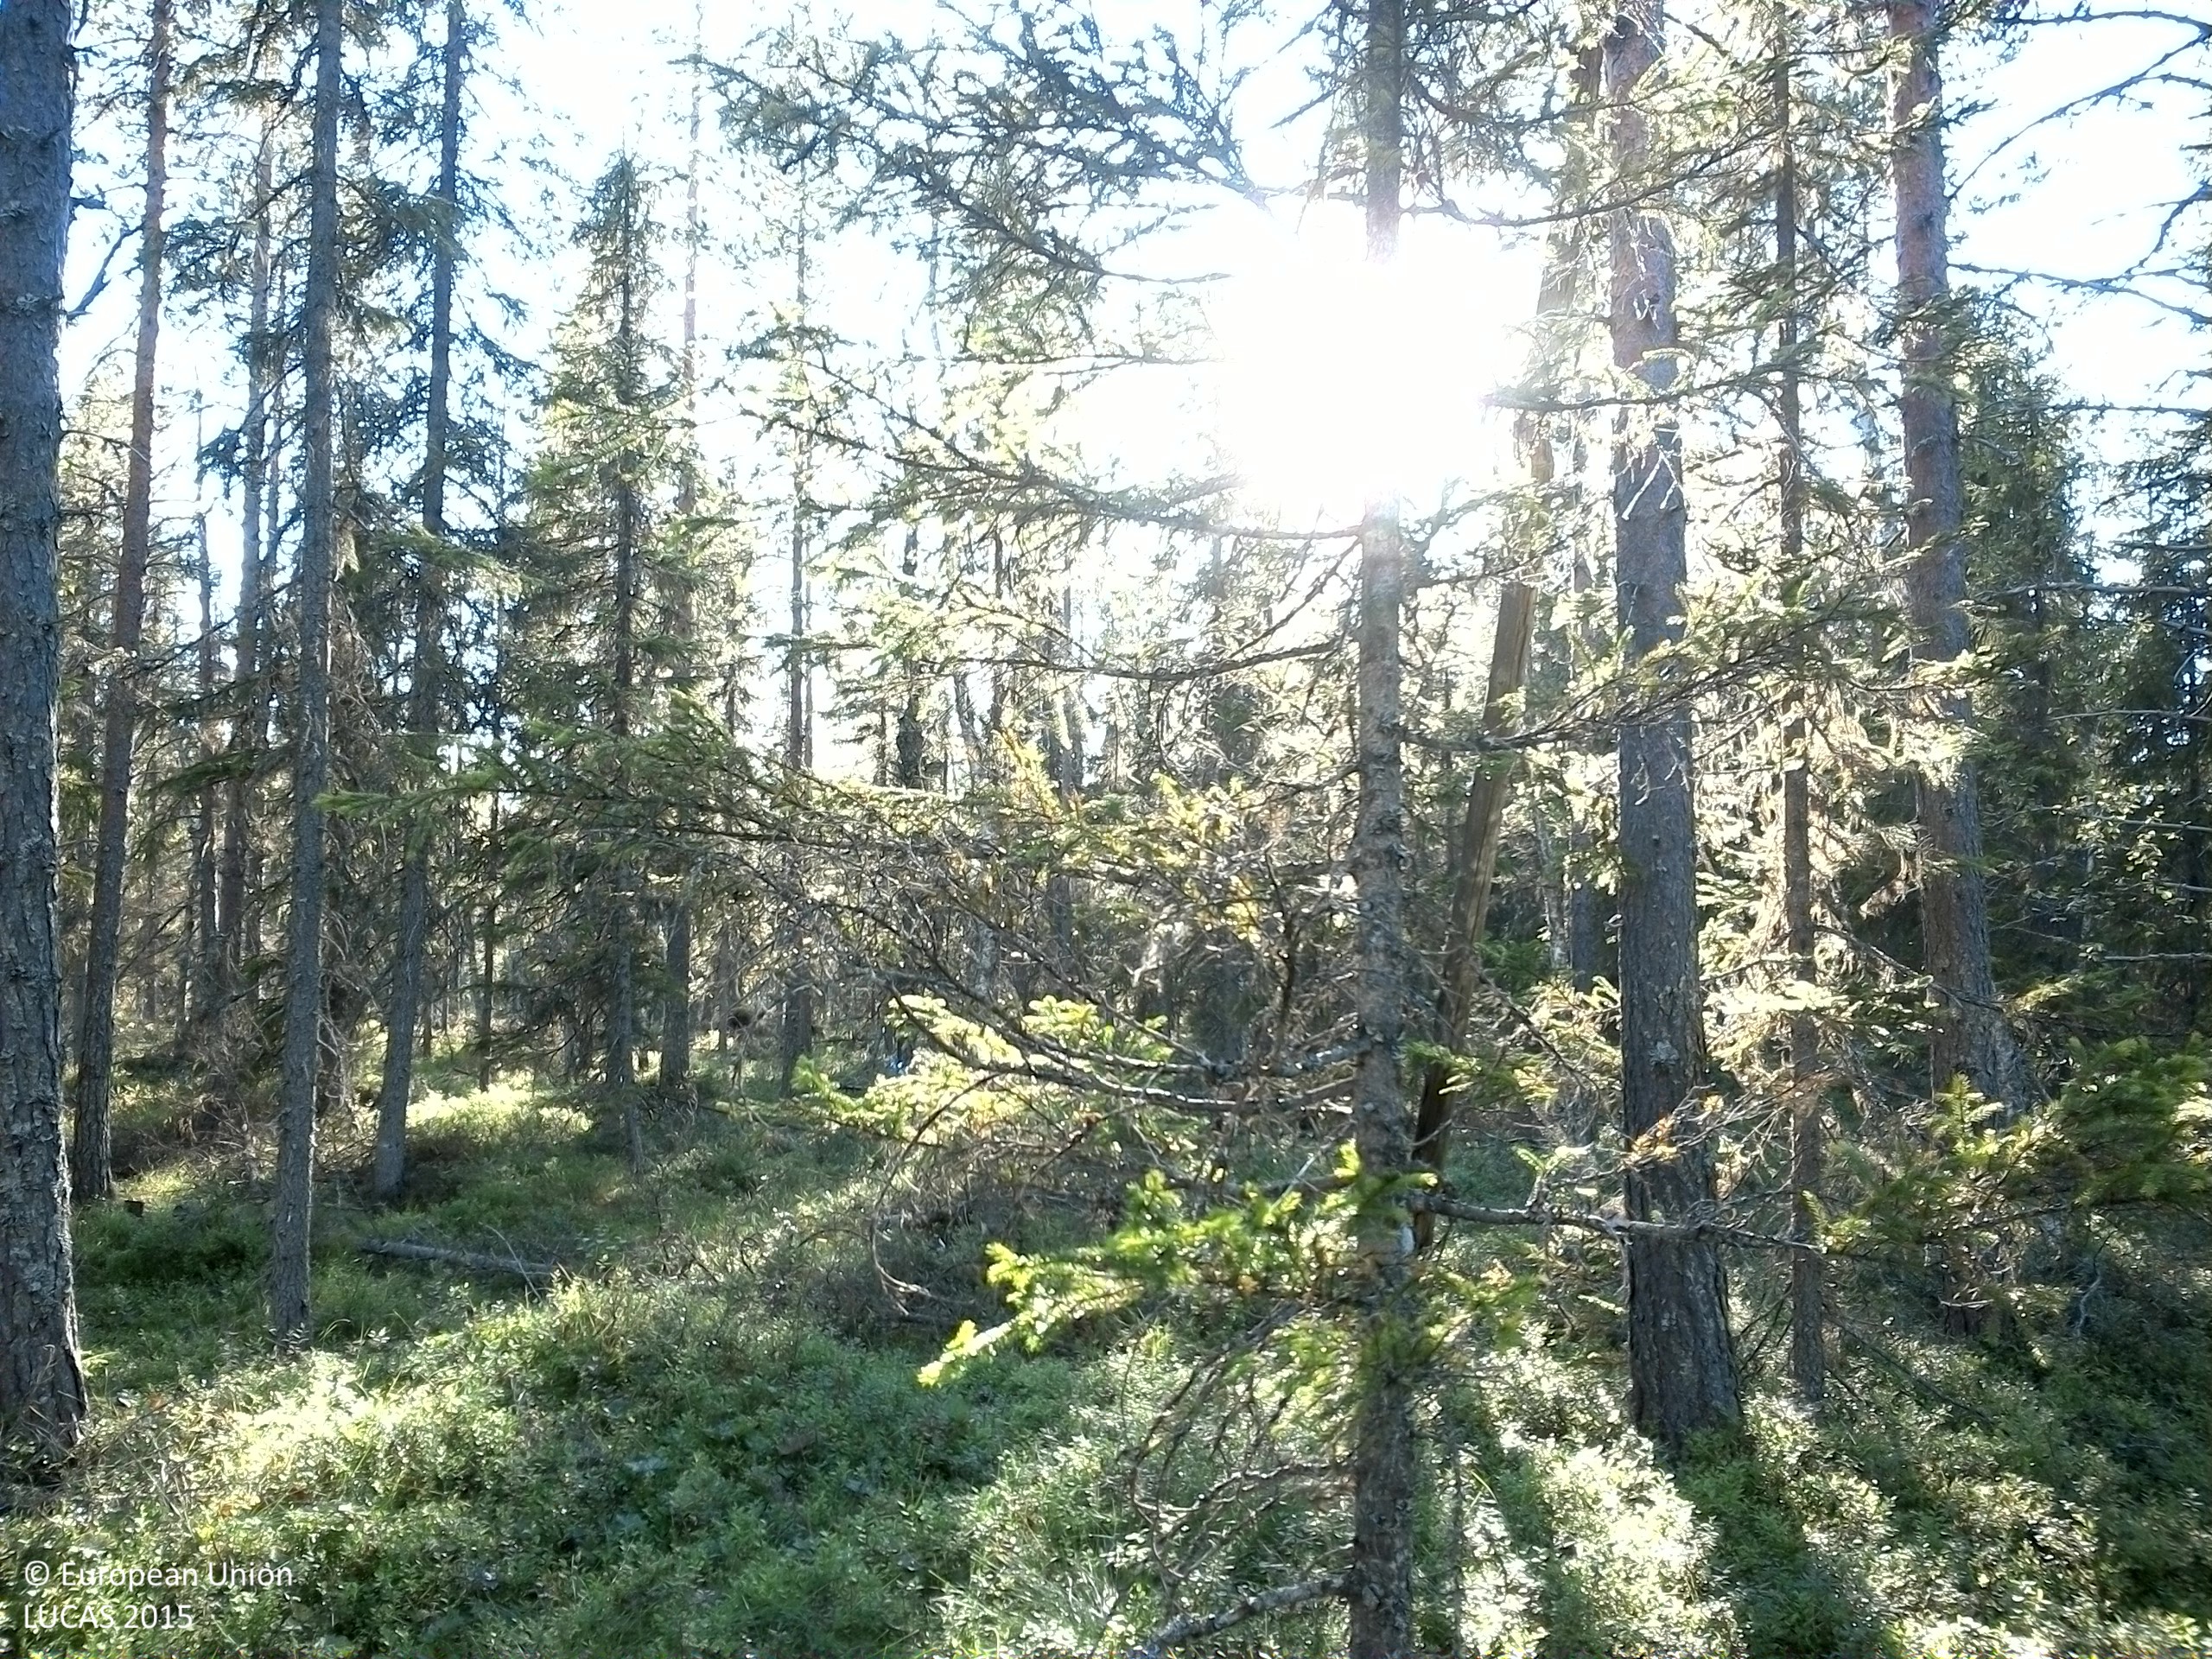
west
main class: Woodland
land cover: Pine dominated coniferous woodland
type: boreal forest
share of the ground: 50 - 75 %
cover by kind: coniferous forest trees 60 %, shrubs 25 %, broadleaved forest trees 5 %, herbaceous plants 5 %, lichens and mosses 5 %
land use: Forestry
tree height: > 5 m
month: August
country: SE
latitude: 63.6918
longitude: 17.5566
